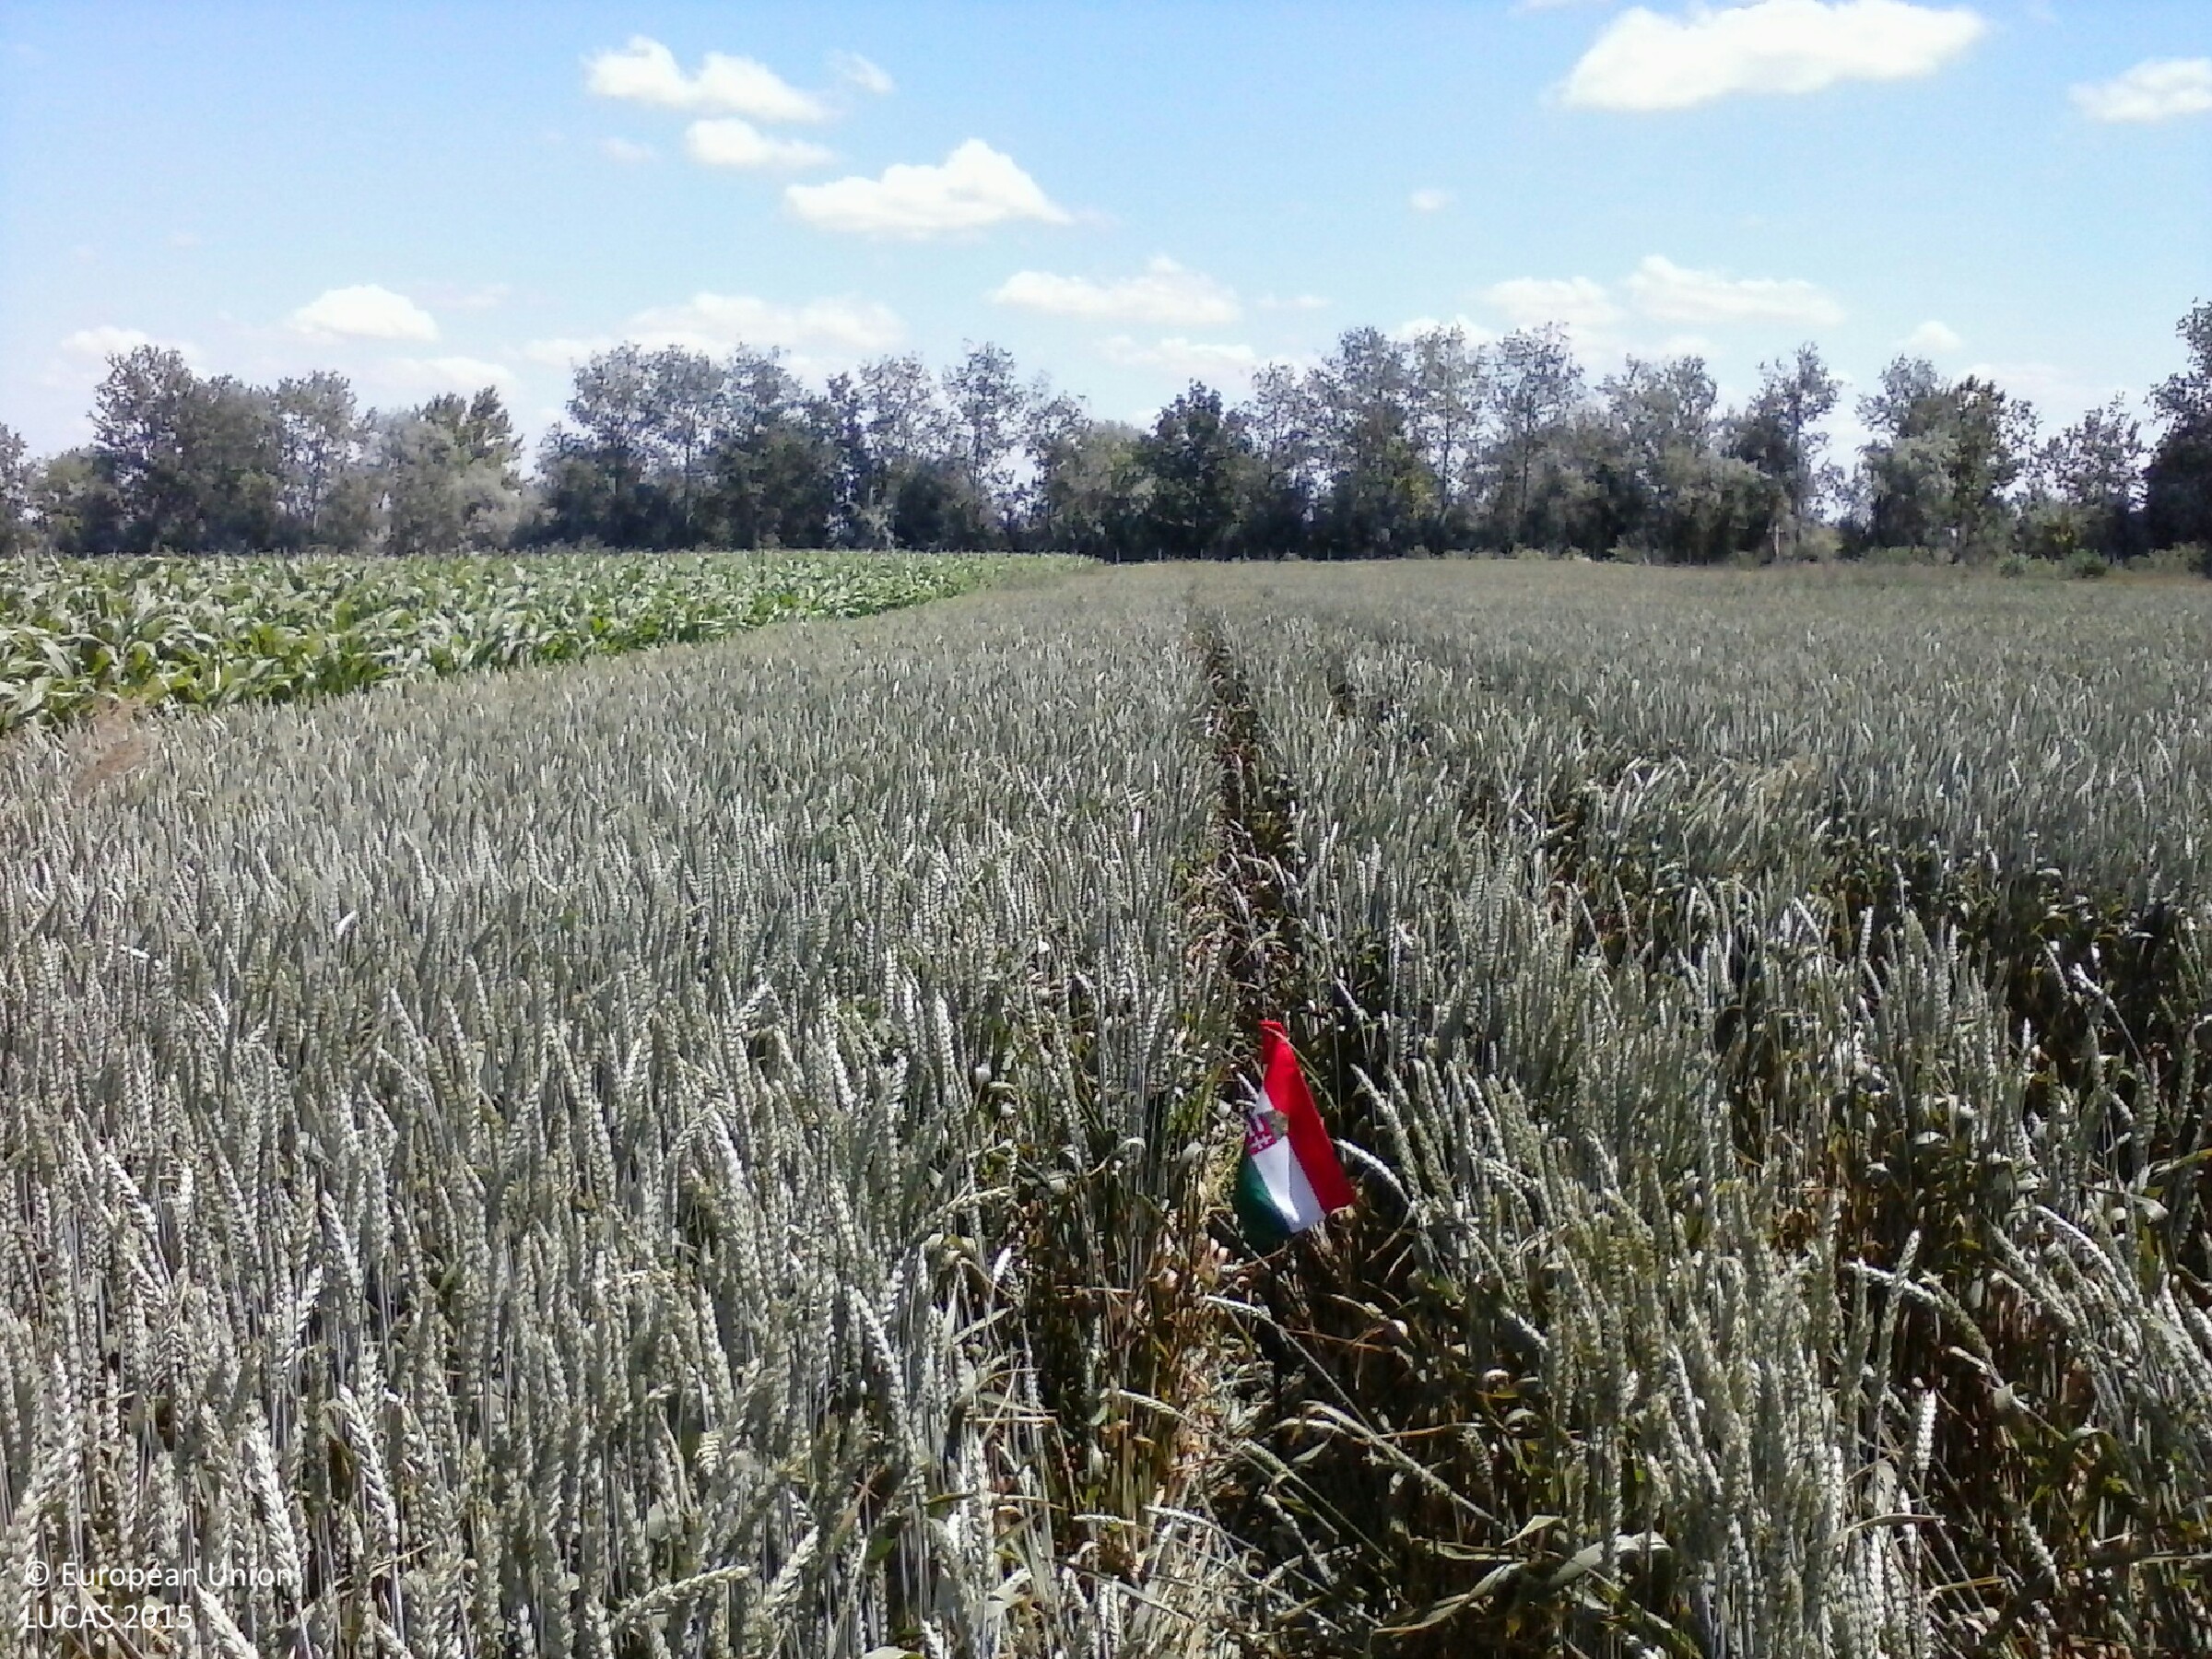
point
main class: Cropland
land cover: Common wheat
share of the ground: > 75 %
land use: Agriculture (excluding fallow land and kitchen gardens)
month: June
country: HU
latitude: 46.2376
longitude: 20.0714
